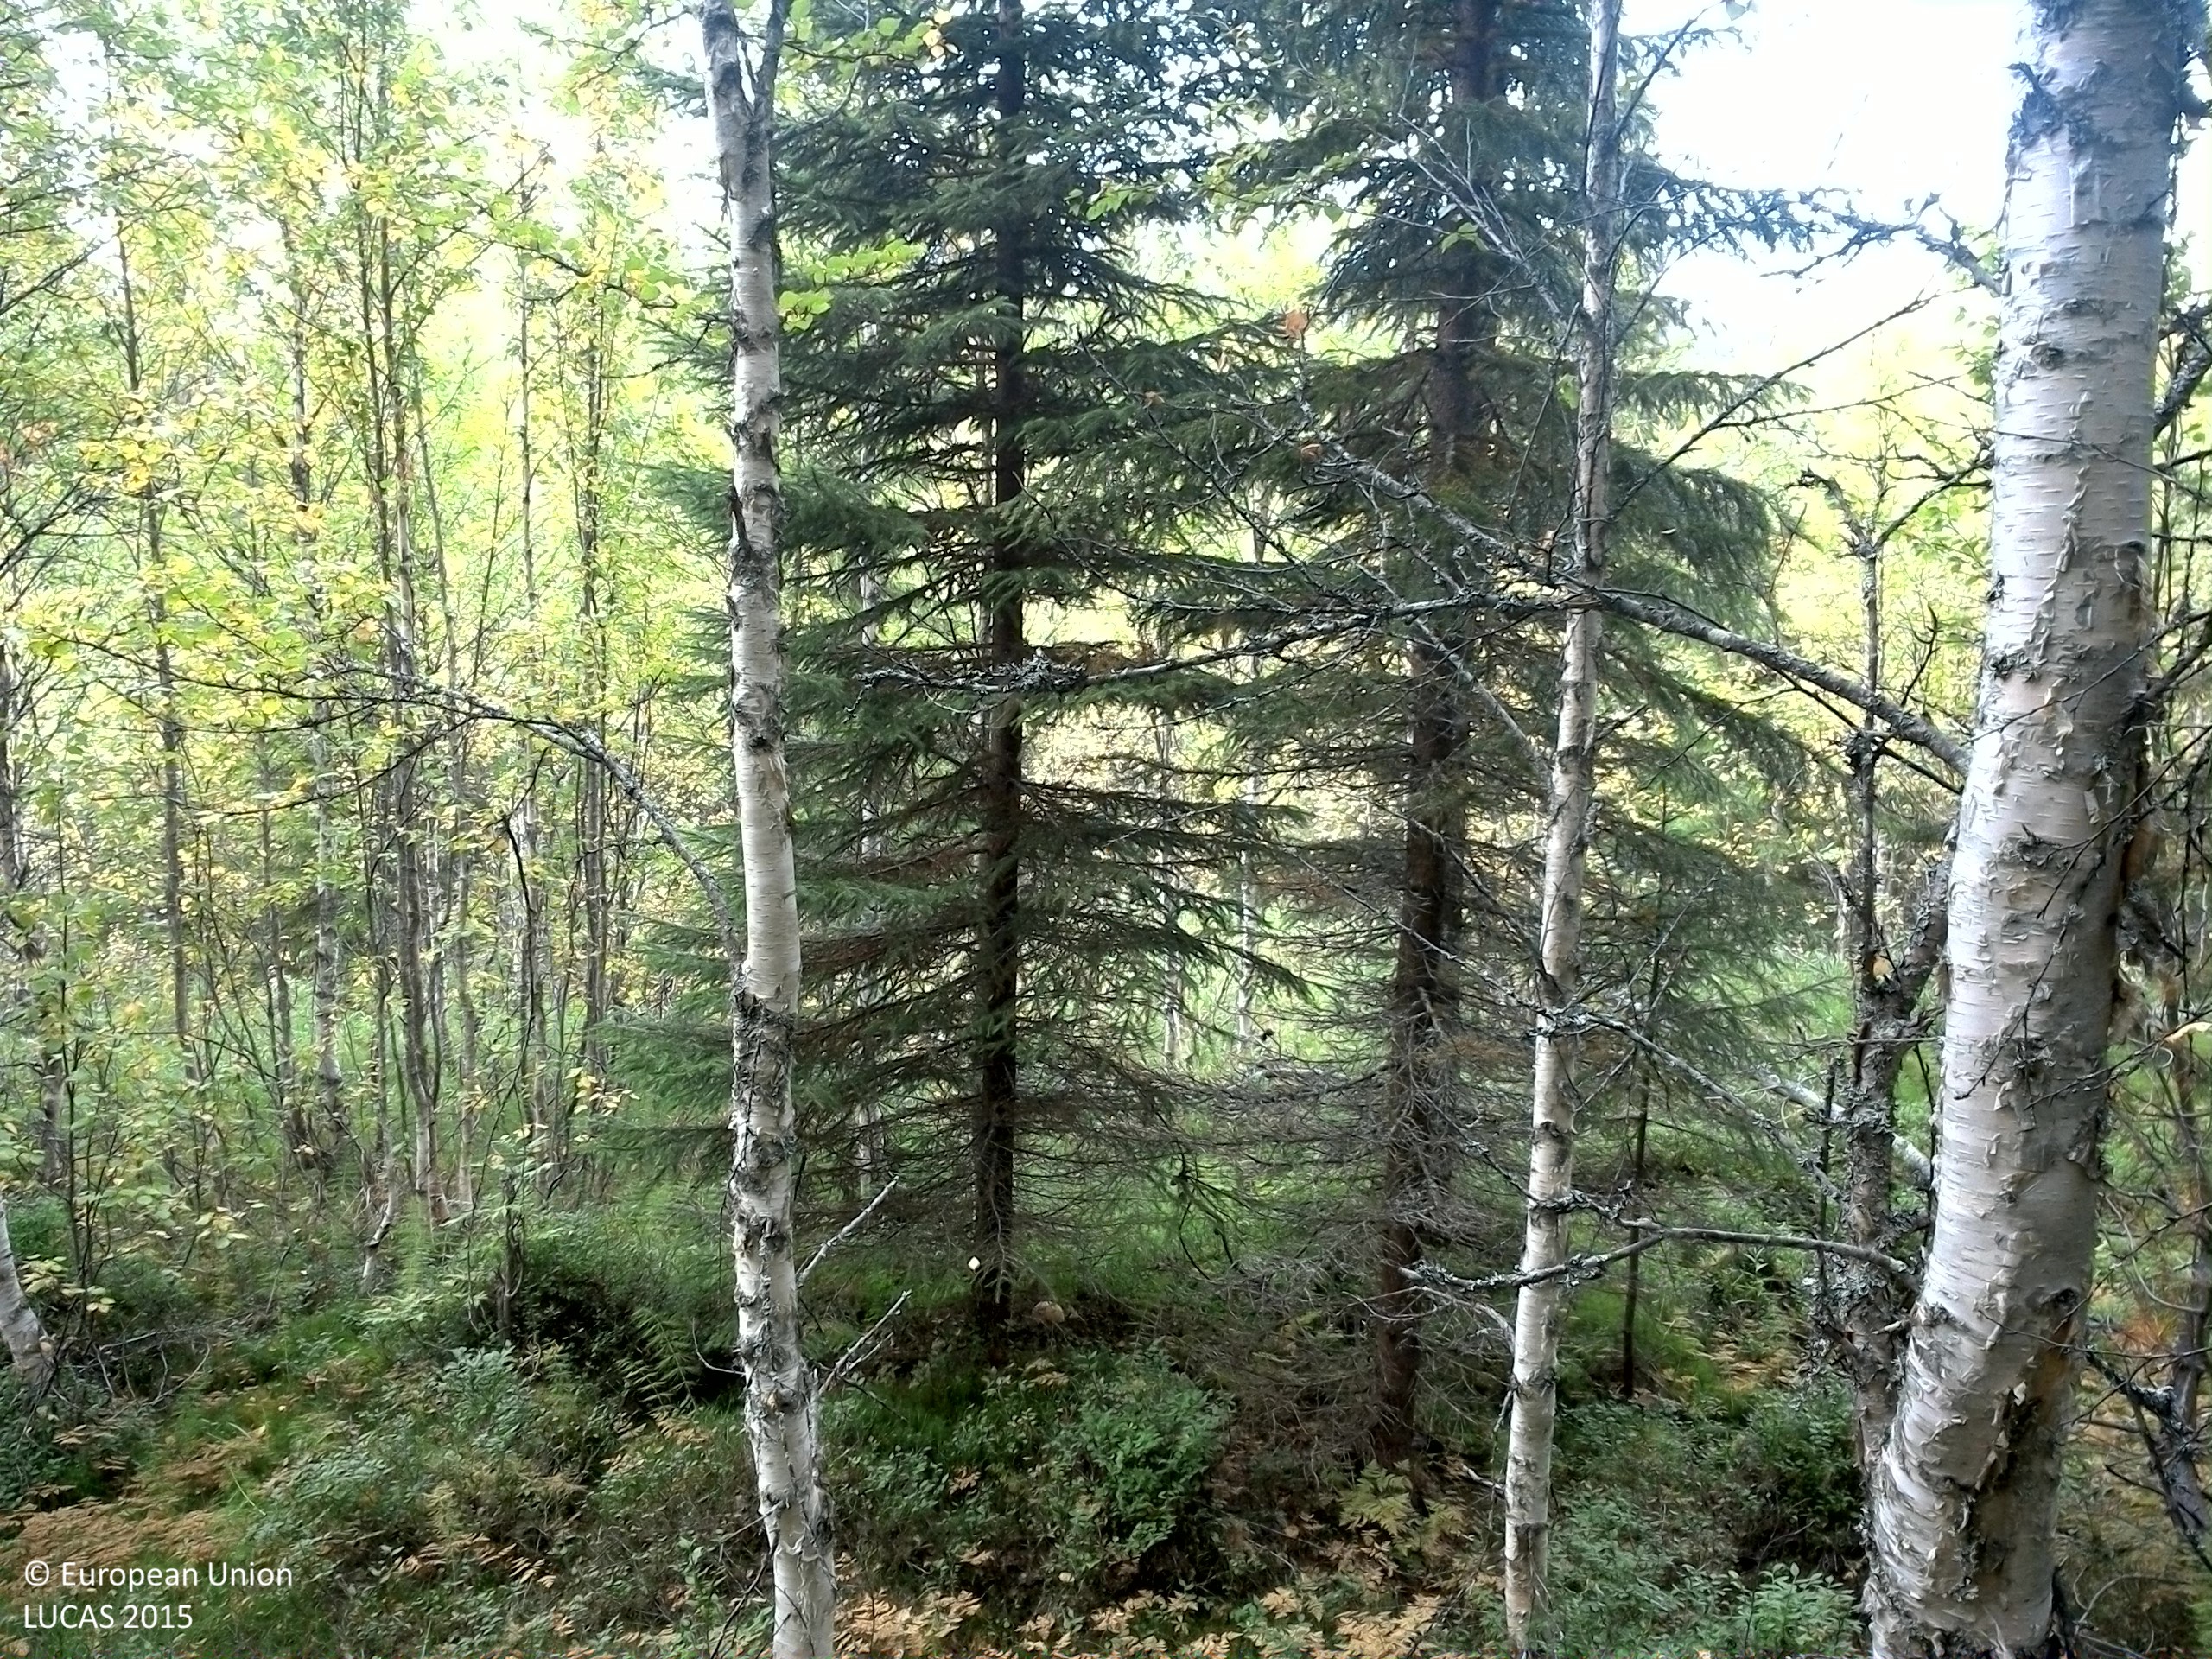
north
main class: Woodland
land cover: Other mixed woodland
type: boreal forest
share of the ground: 50 - 75 %
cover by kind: coniferous forest trees 35 %, broadleaved forest trees 35 %, shrubs 25 %, lichens and mosses 5 %
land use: Forestry
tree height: > 5 m
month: September
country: SE
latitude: 64.0209
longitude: 16.7023
